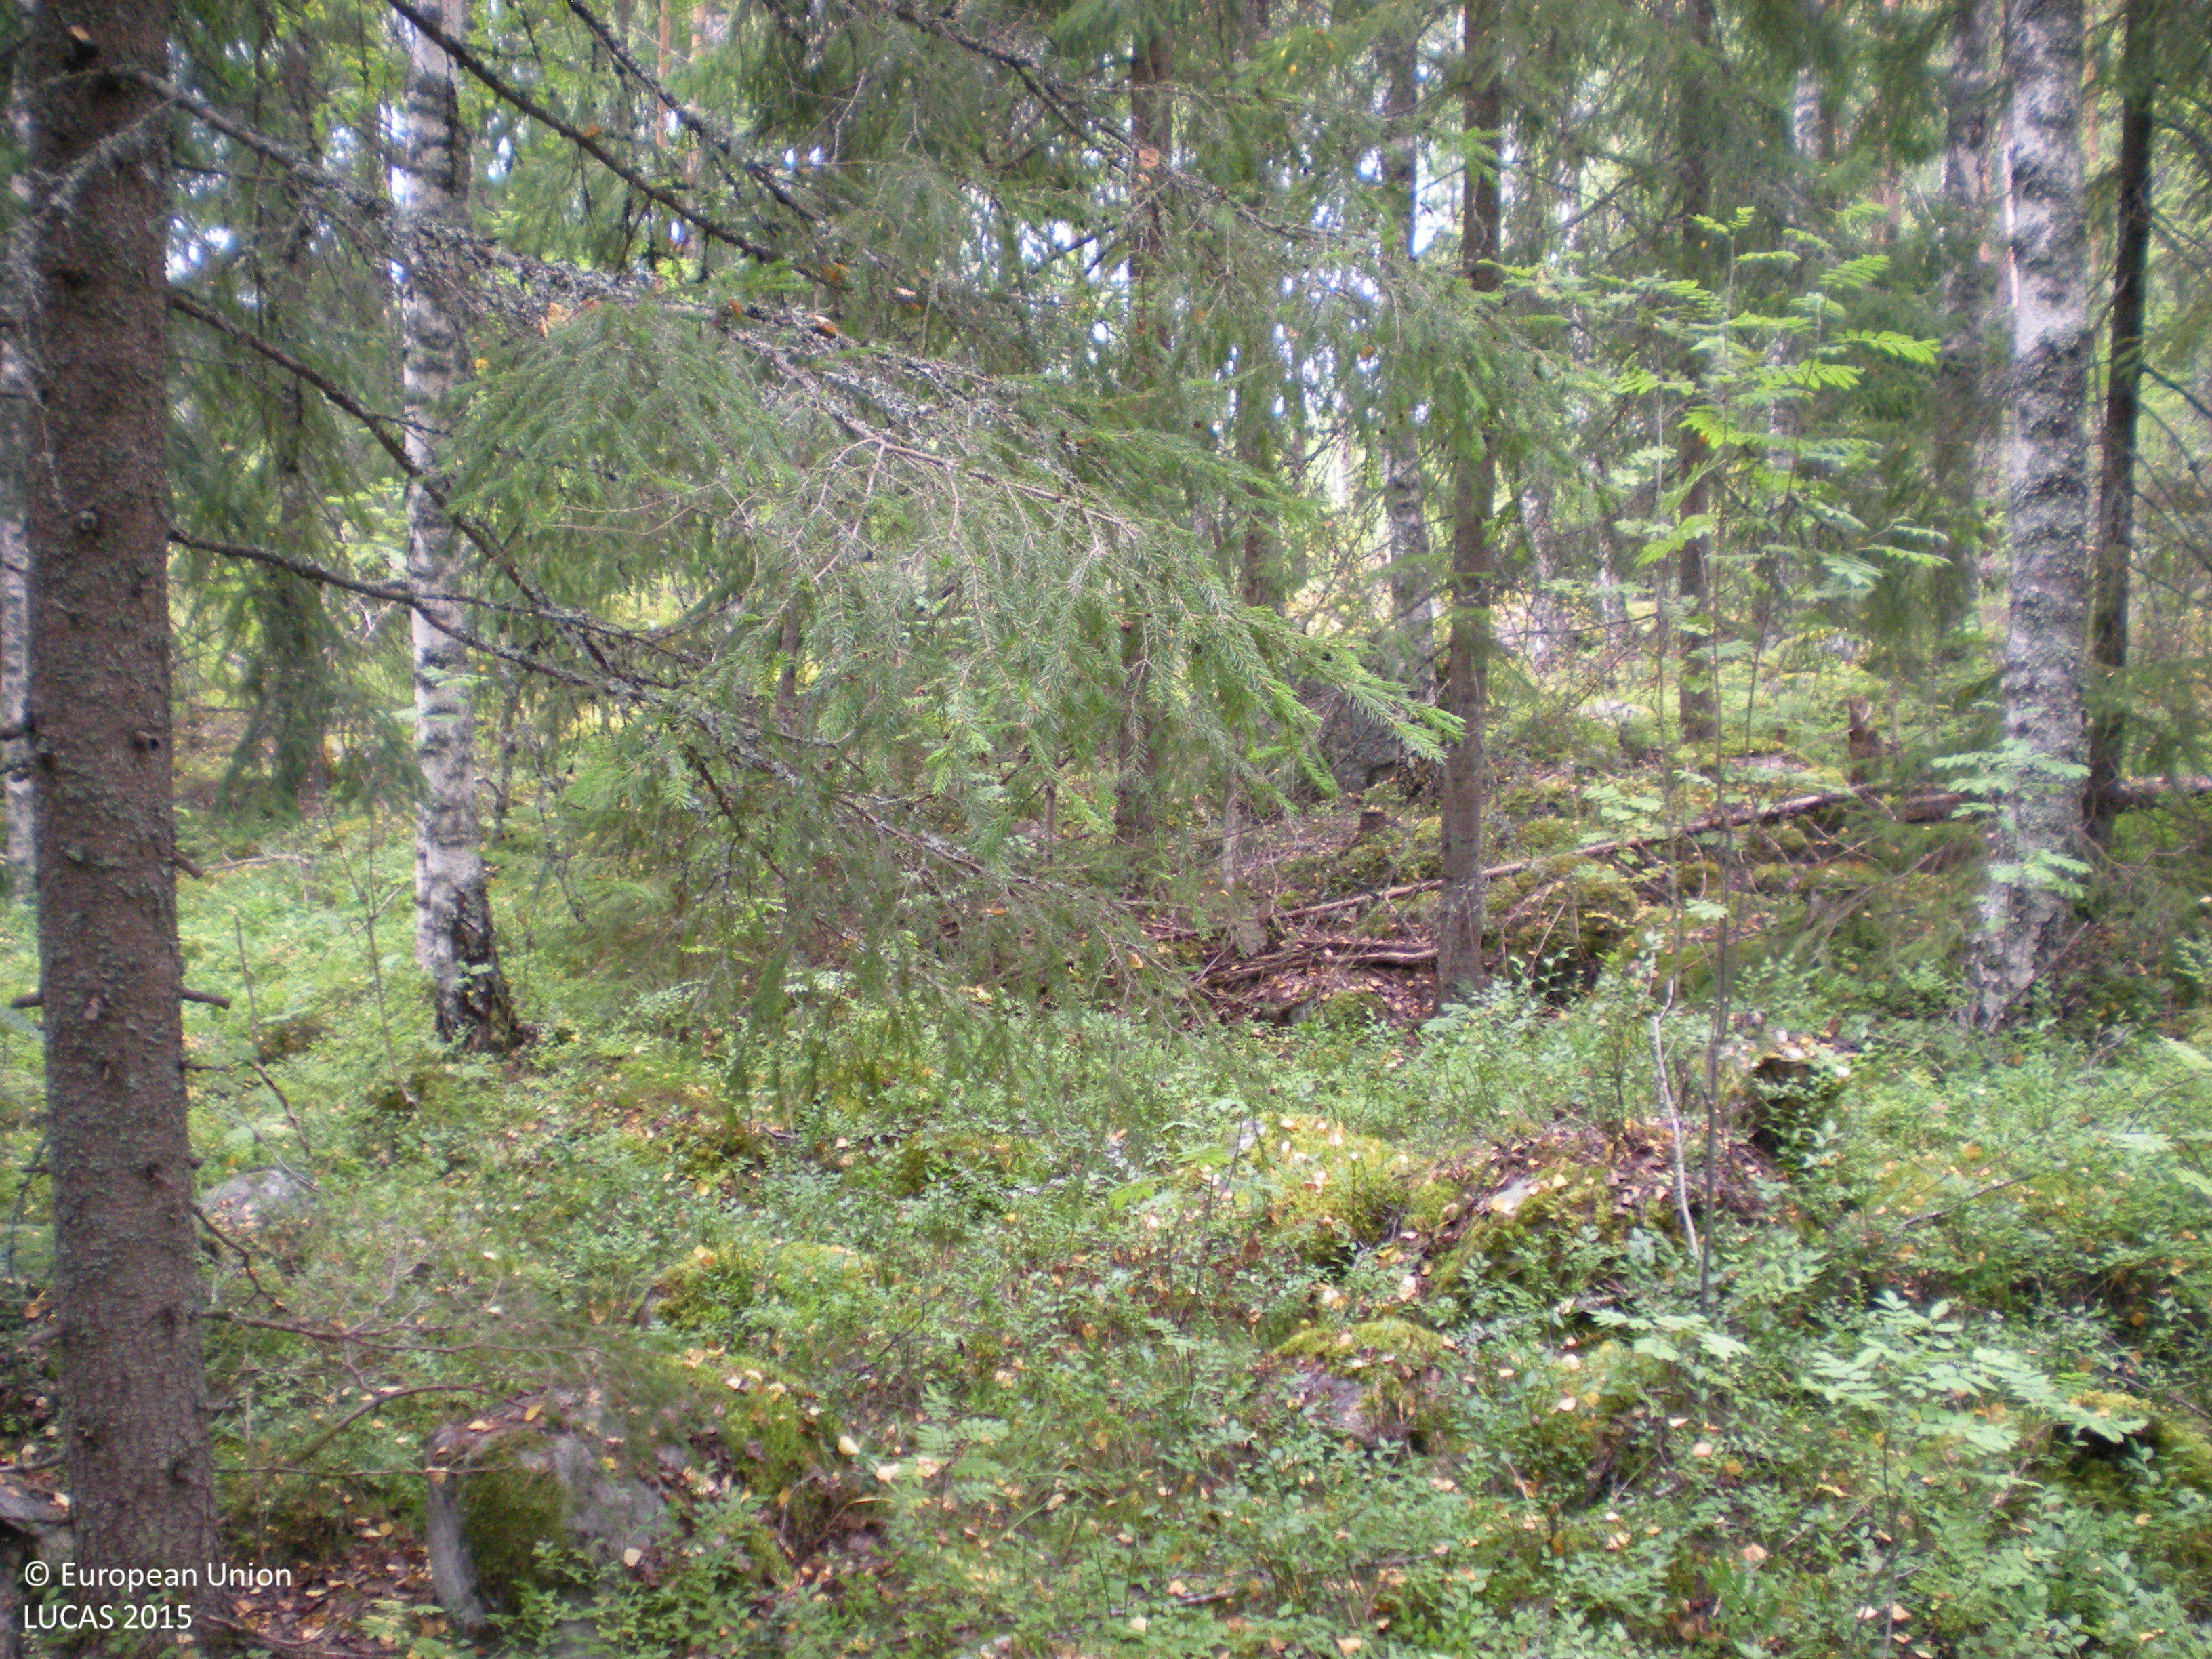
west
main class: Woodland
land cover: Spruce dominated coniferous woodland
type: boreal forest
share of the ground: 50 - 75 %
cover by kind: coniferous forest trees 55 %, shrubs 20 %, broadleaved forest trees 15 %, lichens and mosses 5 %, consolidated bare surface 5 %
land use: Forestry
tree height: > 5 m
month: August
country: SE
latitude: 60.5362
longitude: 17.2621
